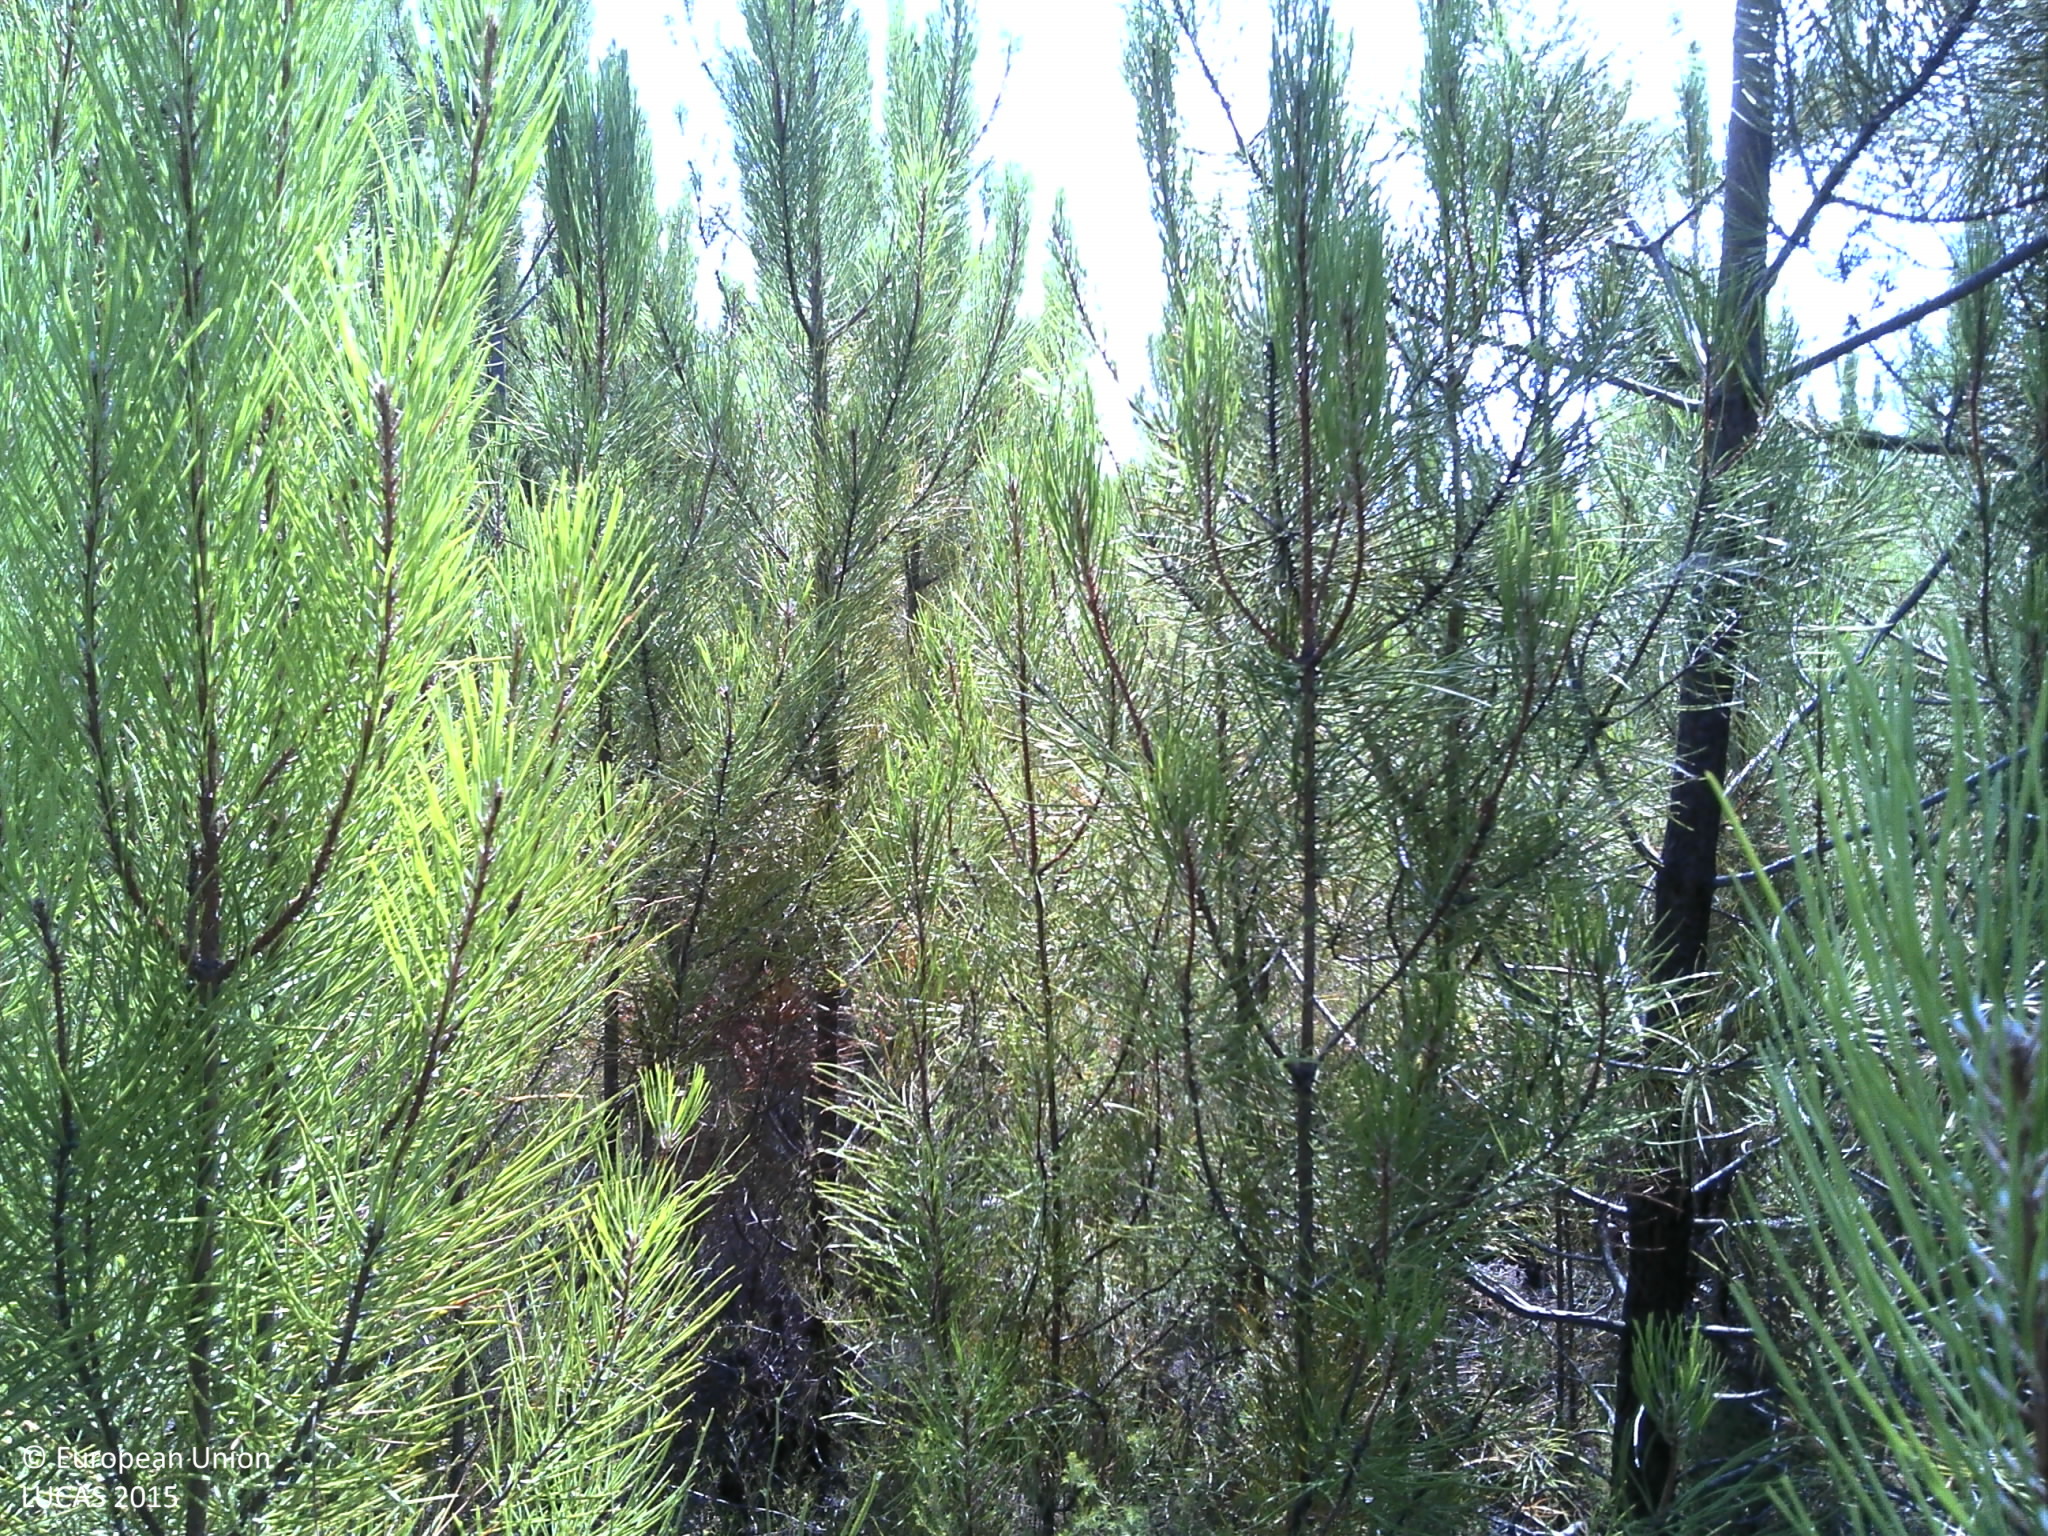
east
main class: Woodland
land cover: Pine dominated coniferous woodland
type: coniferous forest of the mediterranean region
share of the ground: 50 - 75 %
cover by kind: coniferous forest trees 55 %, unconsolidated bare surface 25 %, shrubs 20 %
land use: Forestry
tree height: < 5 m
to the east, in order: Pine dominated coniferous woodland; Tracks; Pine dominated coniferous woodland; Shrubland without tree cover; Electric lines; Shrubland without tree cover; Pine dominated coniferous woodland
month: July
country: PT
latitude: 39.8199
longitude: -7.8299
